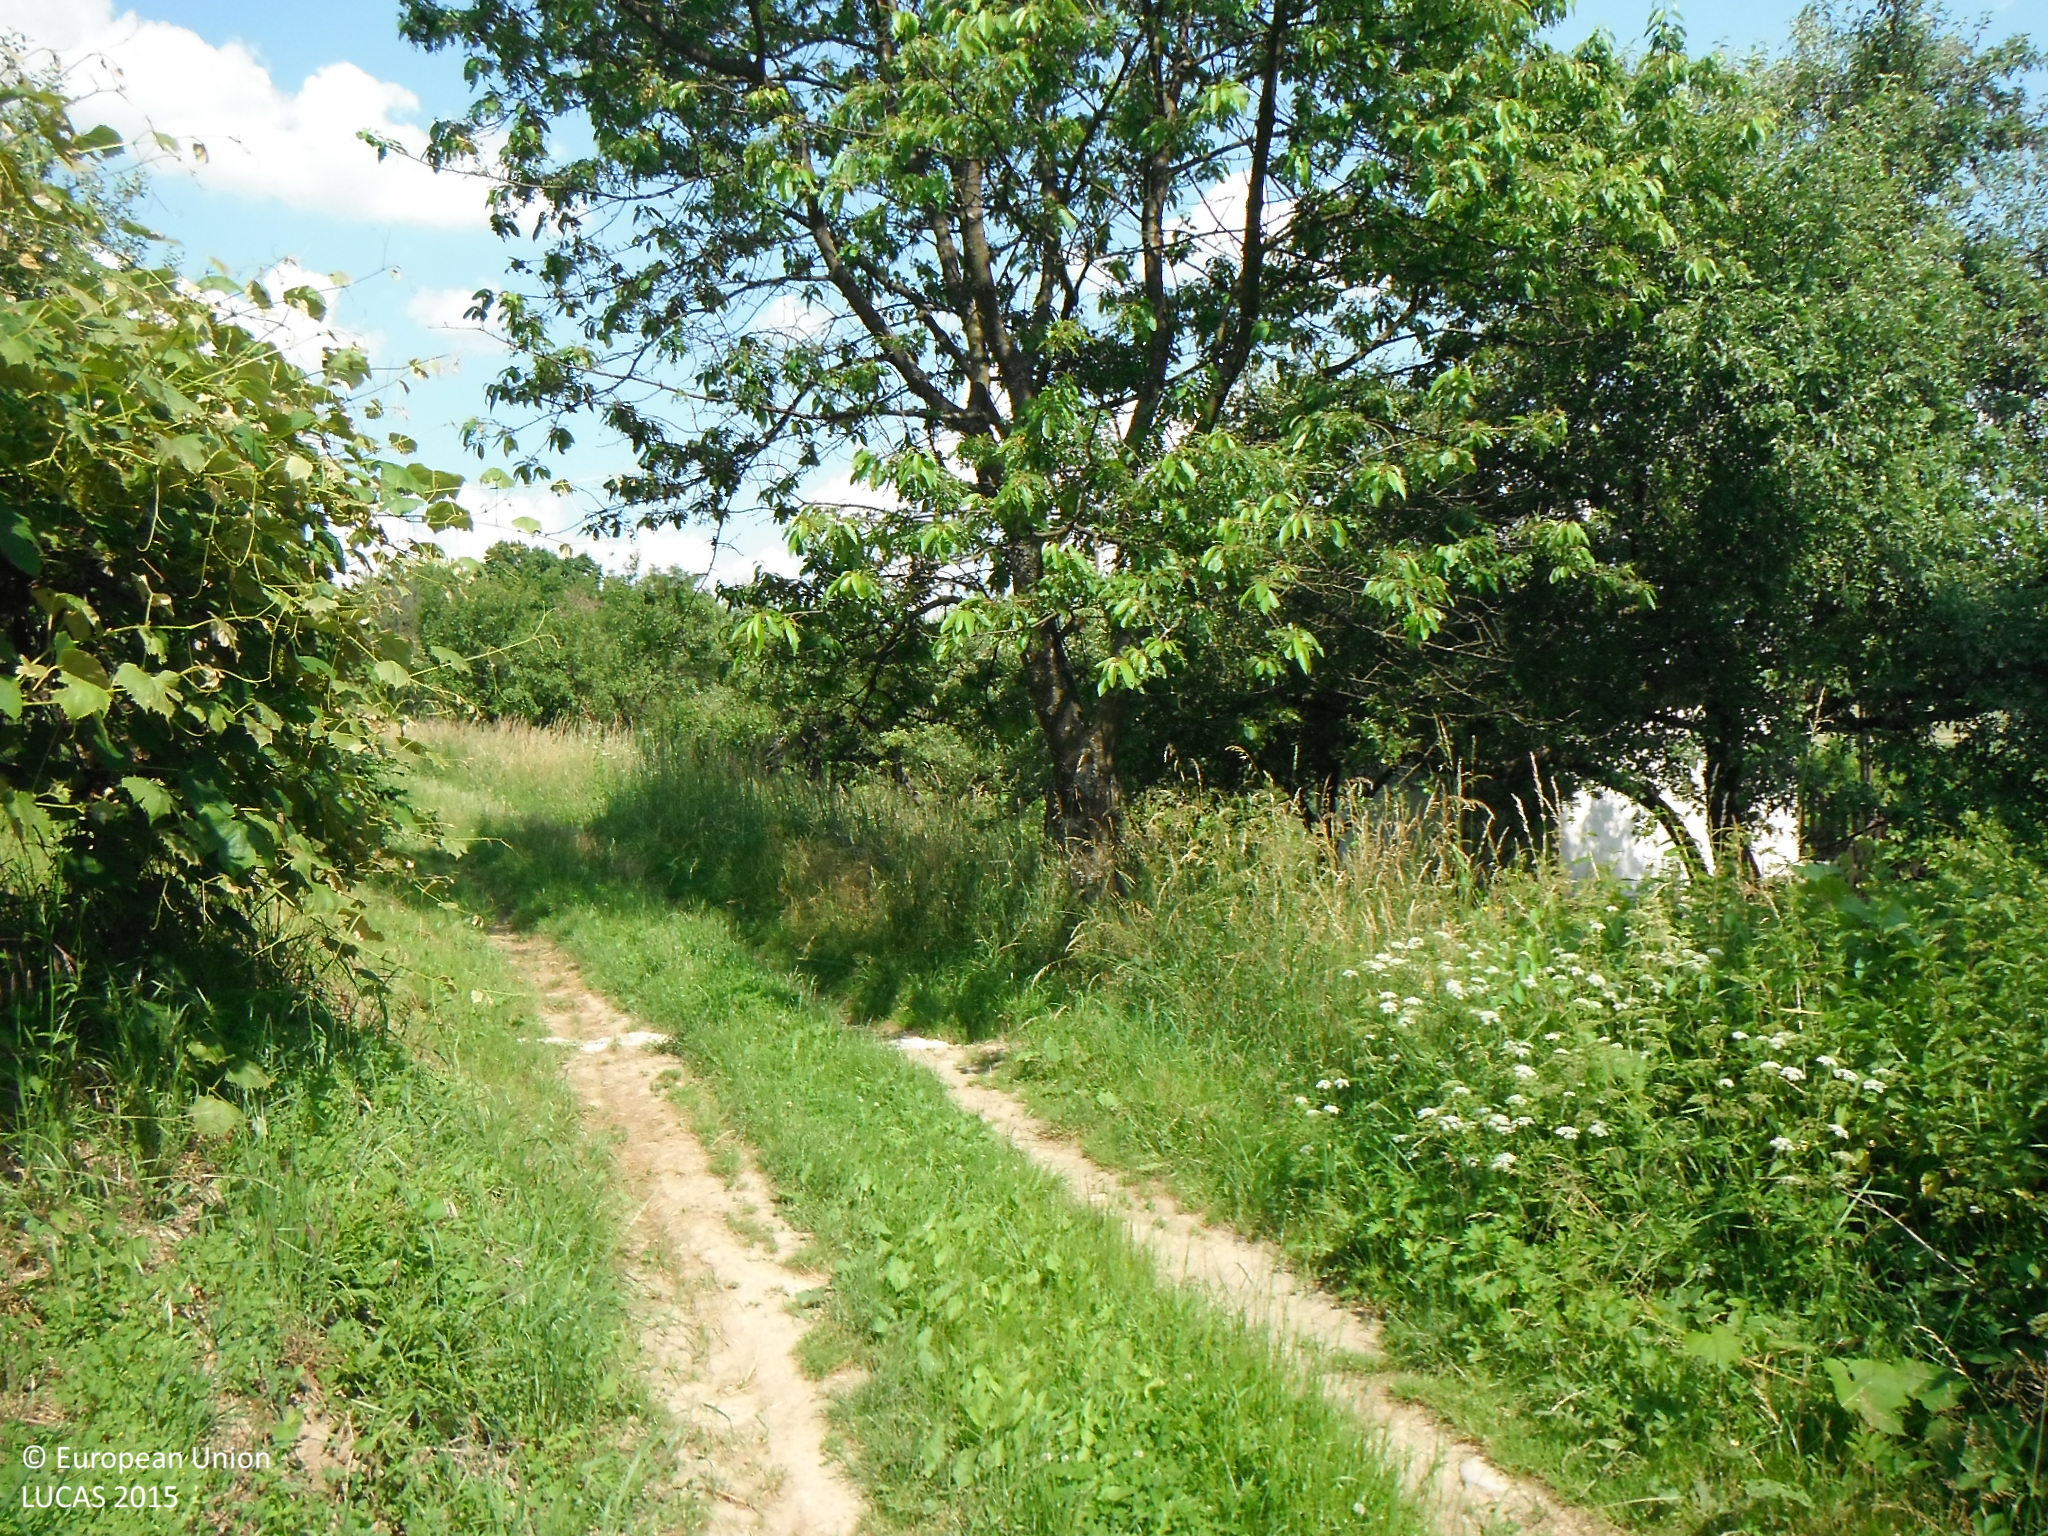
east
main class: Cropland
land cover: Apple fruit
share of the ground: 50 - 75 %
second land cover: Grassland without tree/shrub cover
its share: > 75 %
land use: Kitchen garden
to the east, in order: Apple fruit; Grassland without tree/shrub cover; Artificial constructions in urban areas; Grassland without tree/shrub cover
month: June
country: SK
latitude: 48.4619
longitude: 19.5321
